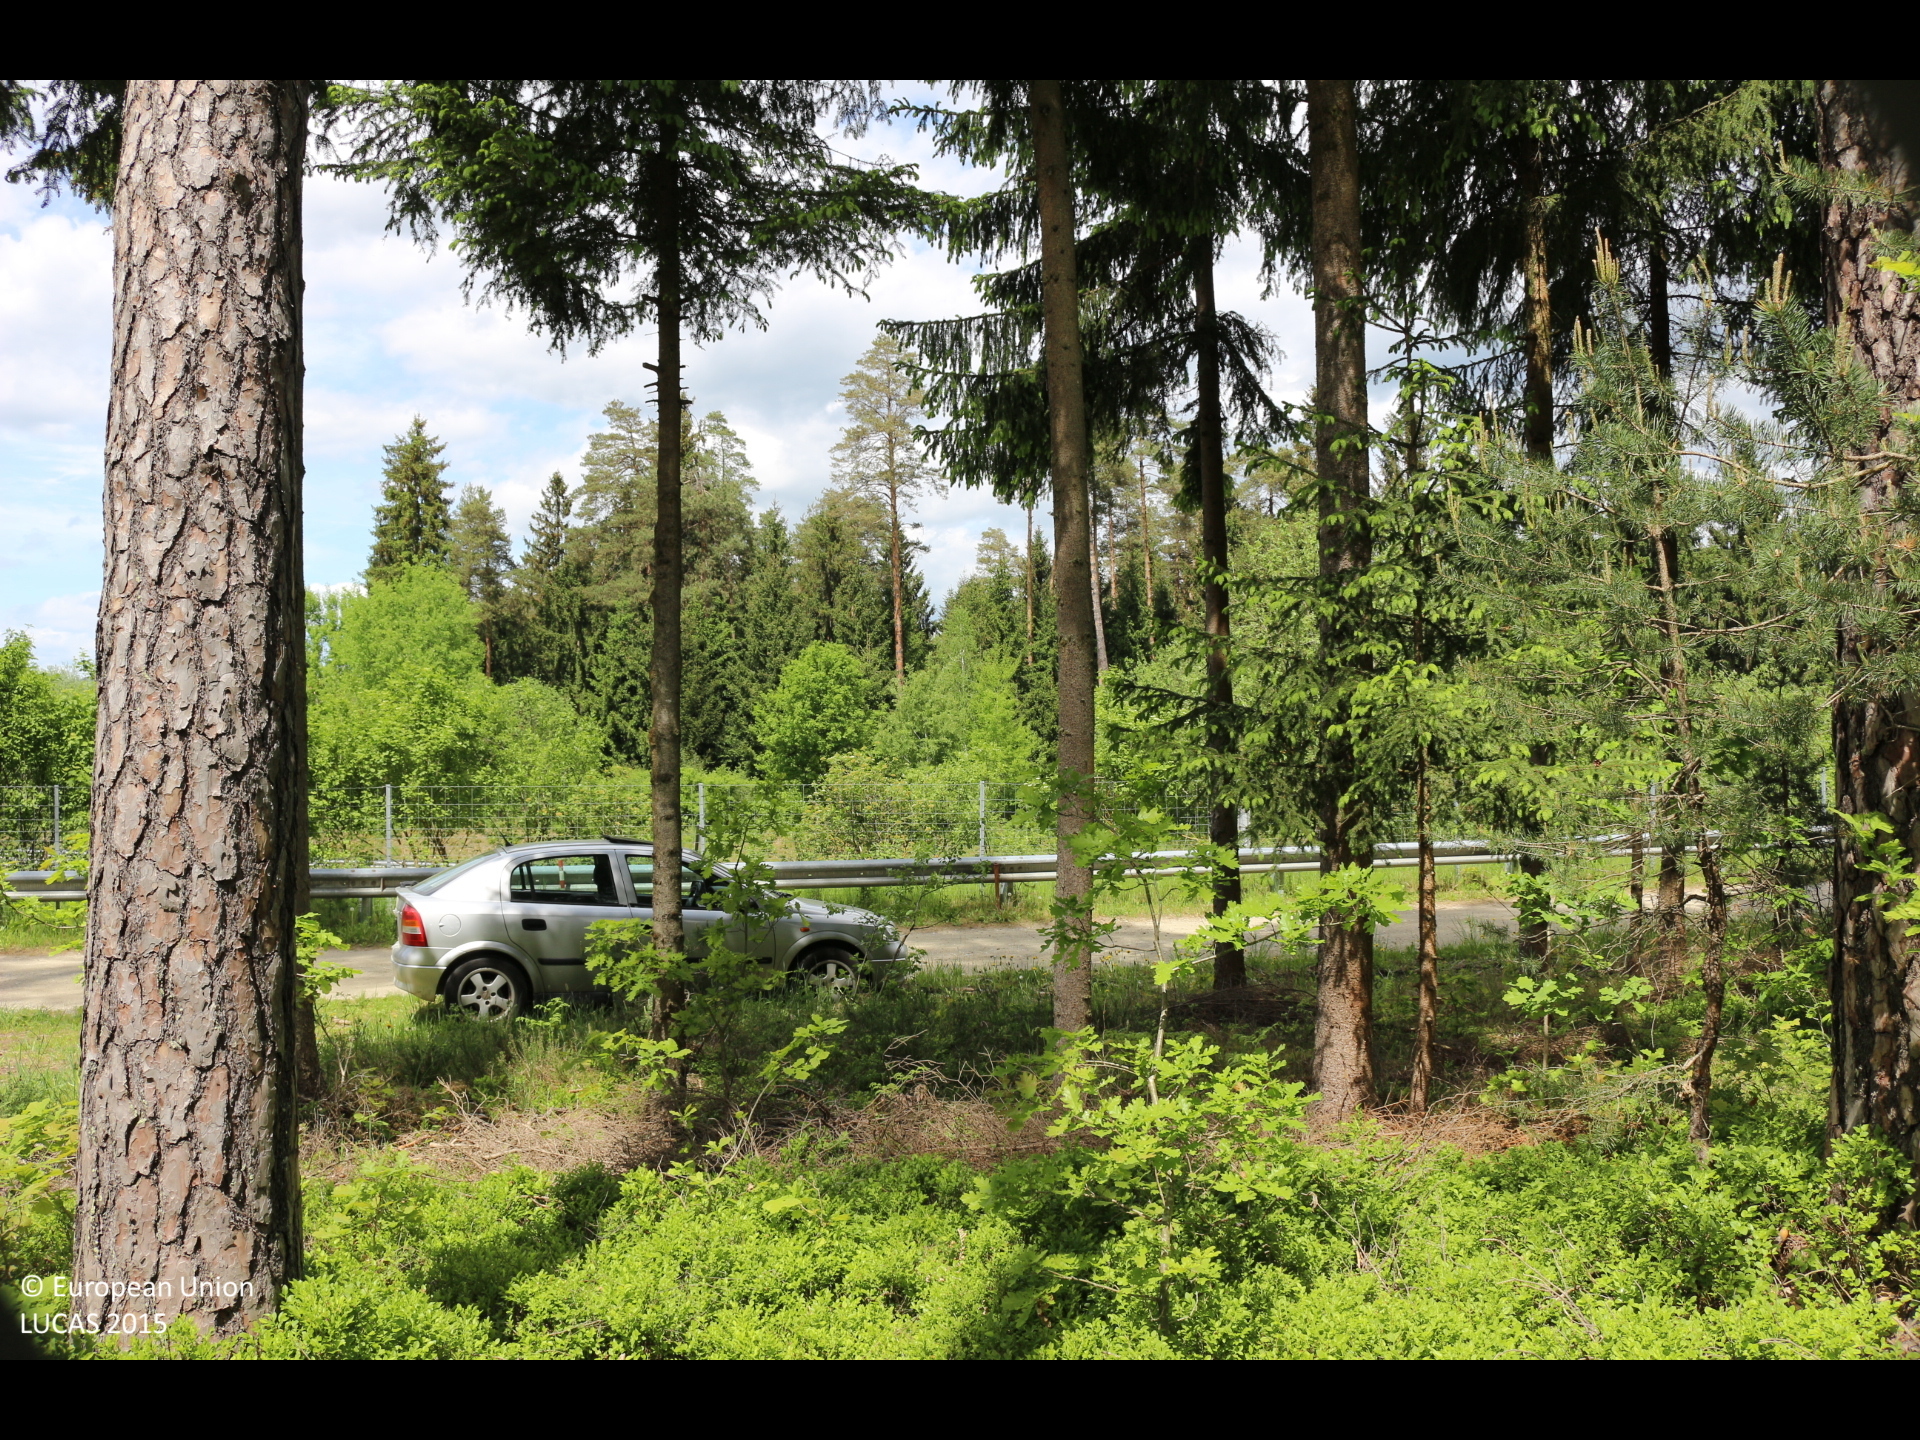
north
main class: Woodland
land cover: Other coniferous woodland
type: alpine coniferous forest
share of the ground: > 75 %
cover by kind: coniferous forest trees 90 %, shrubs 10 %
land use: Forestry
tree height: > 5 m
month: May
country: AT
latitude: 46.6373
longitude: 14.4521
